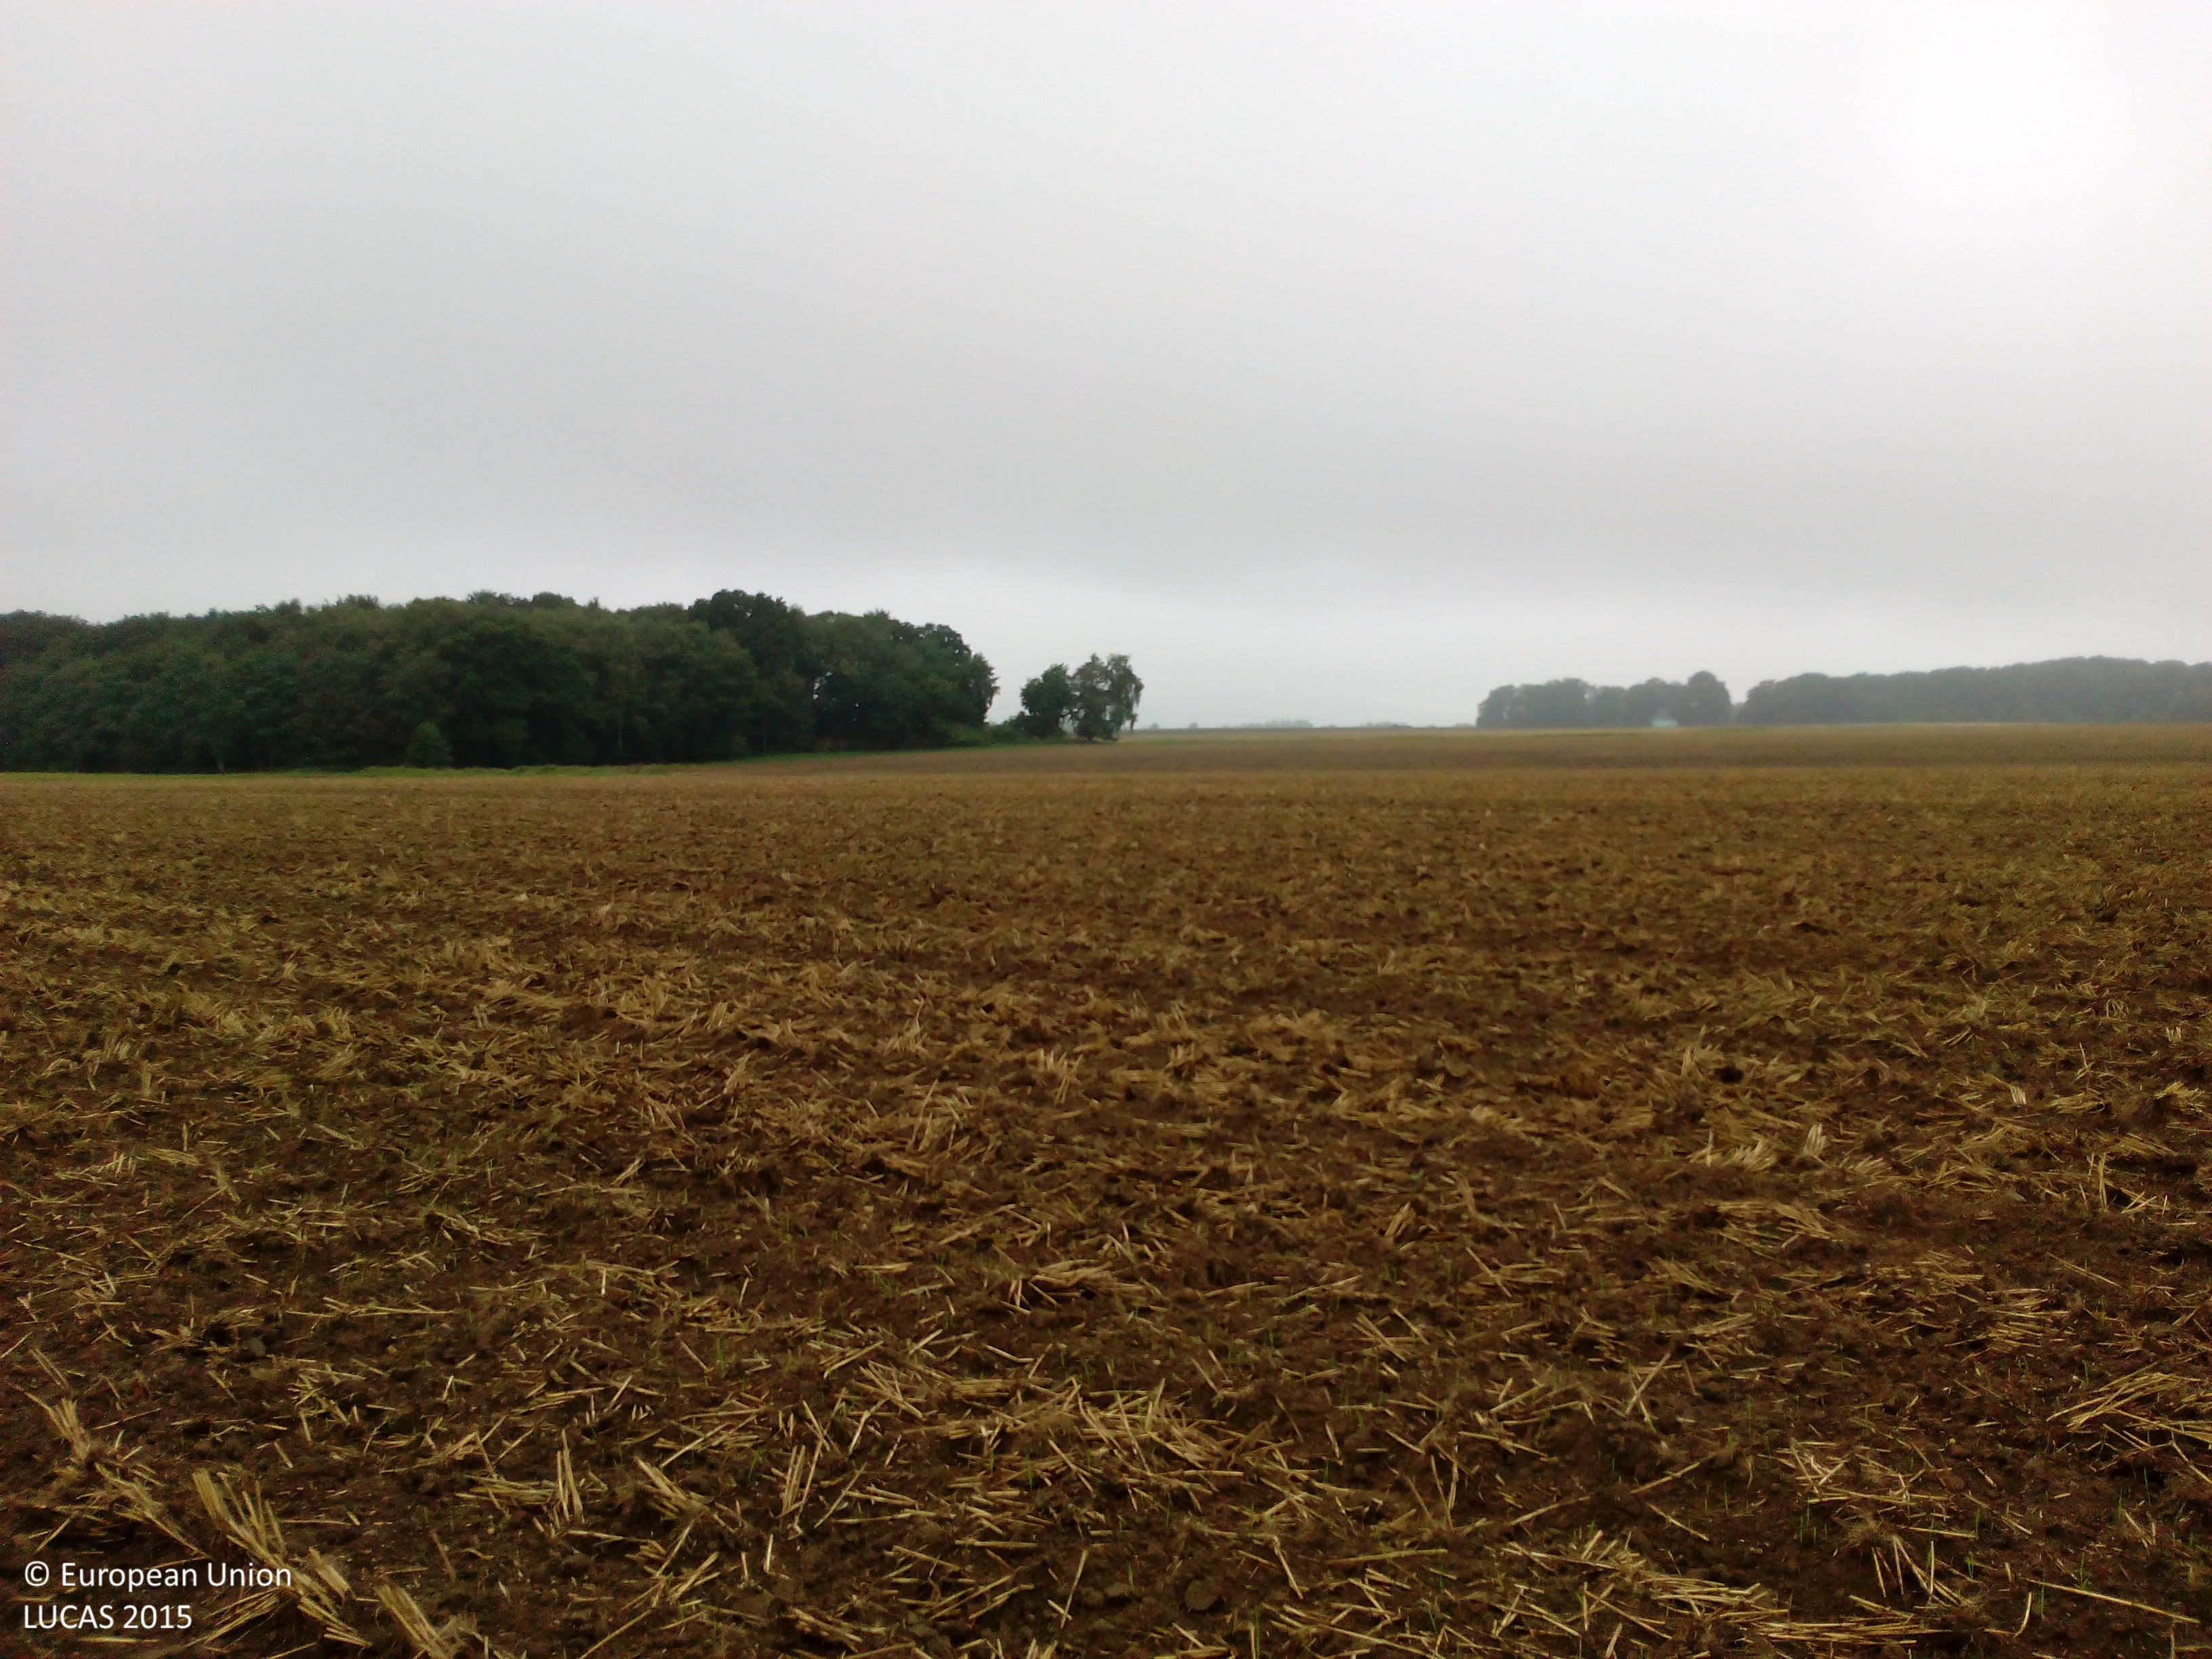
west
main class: Cropland
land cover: Common wheat
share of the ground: < 10 %
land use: Agriculture (excluding fallow land and kitchen gardens)
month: August
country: DE
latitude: 52.7998
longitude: 8.5321
